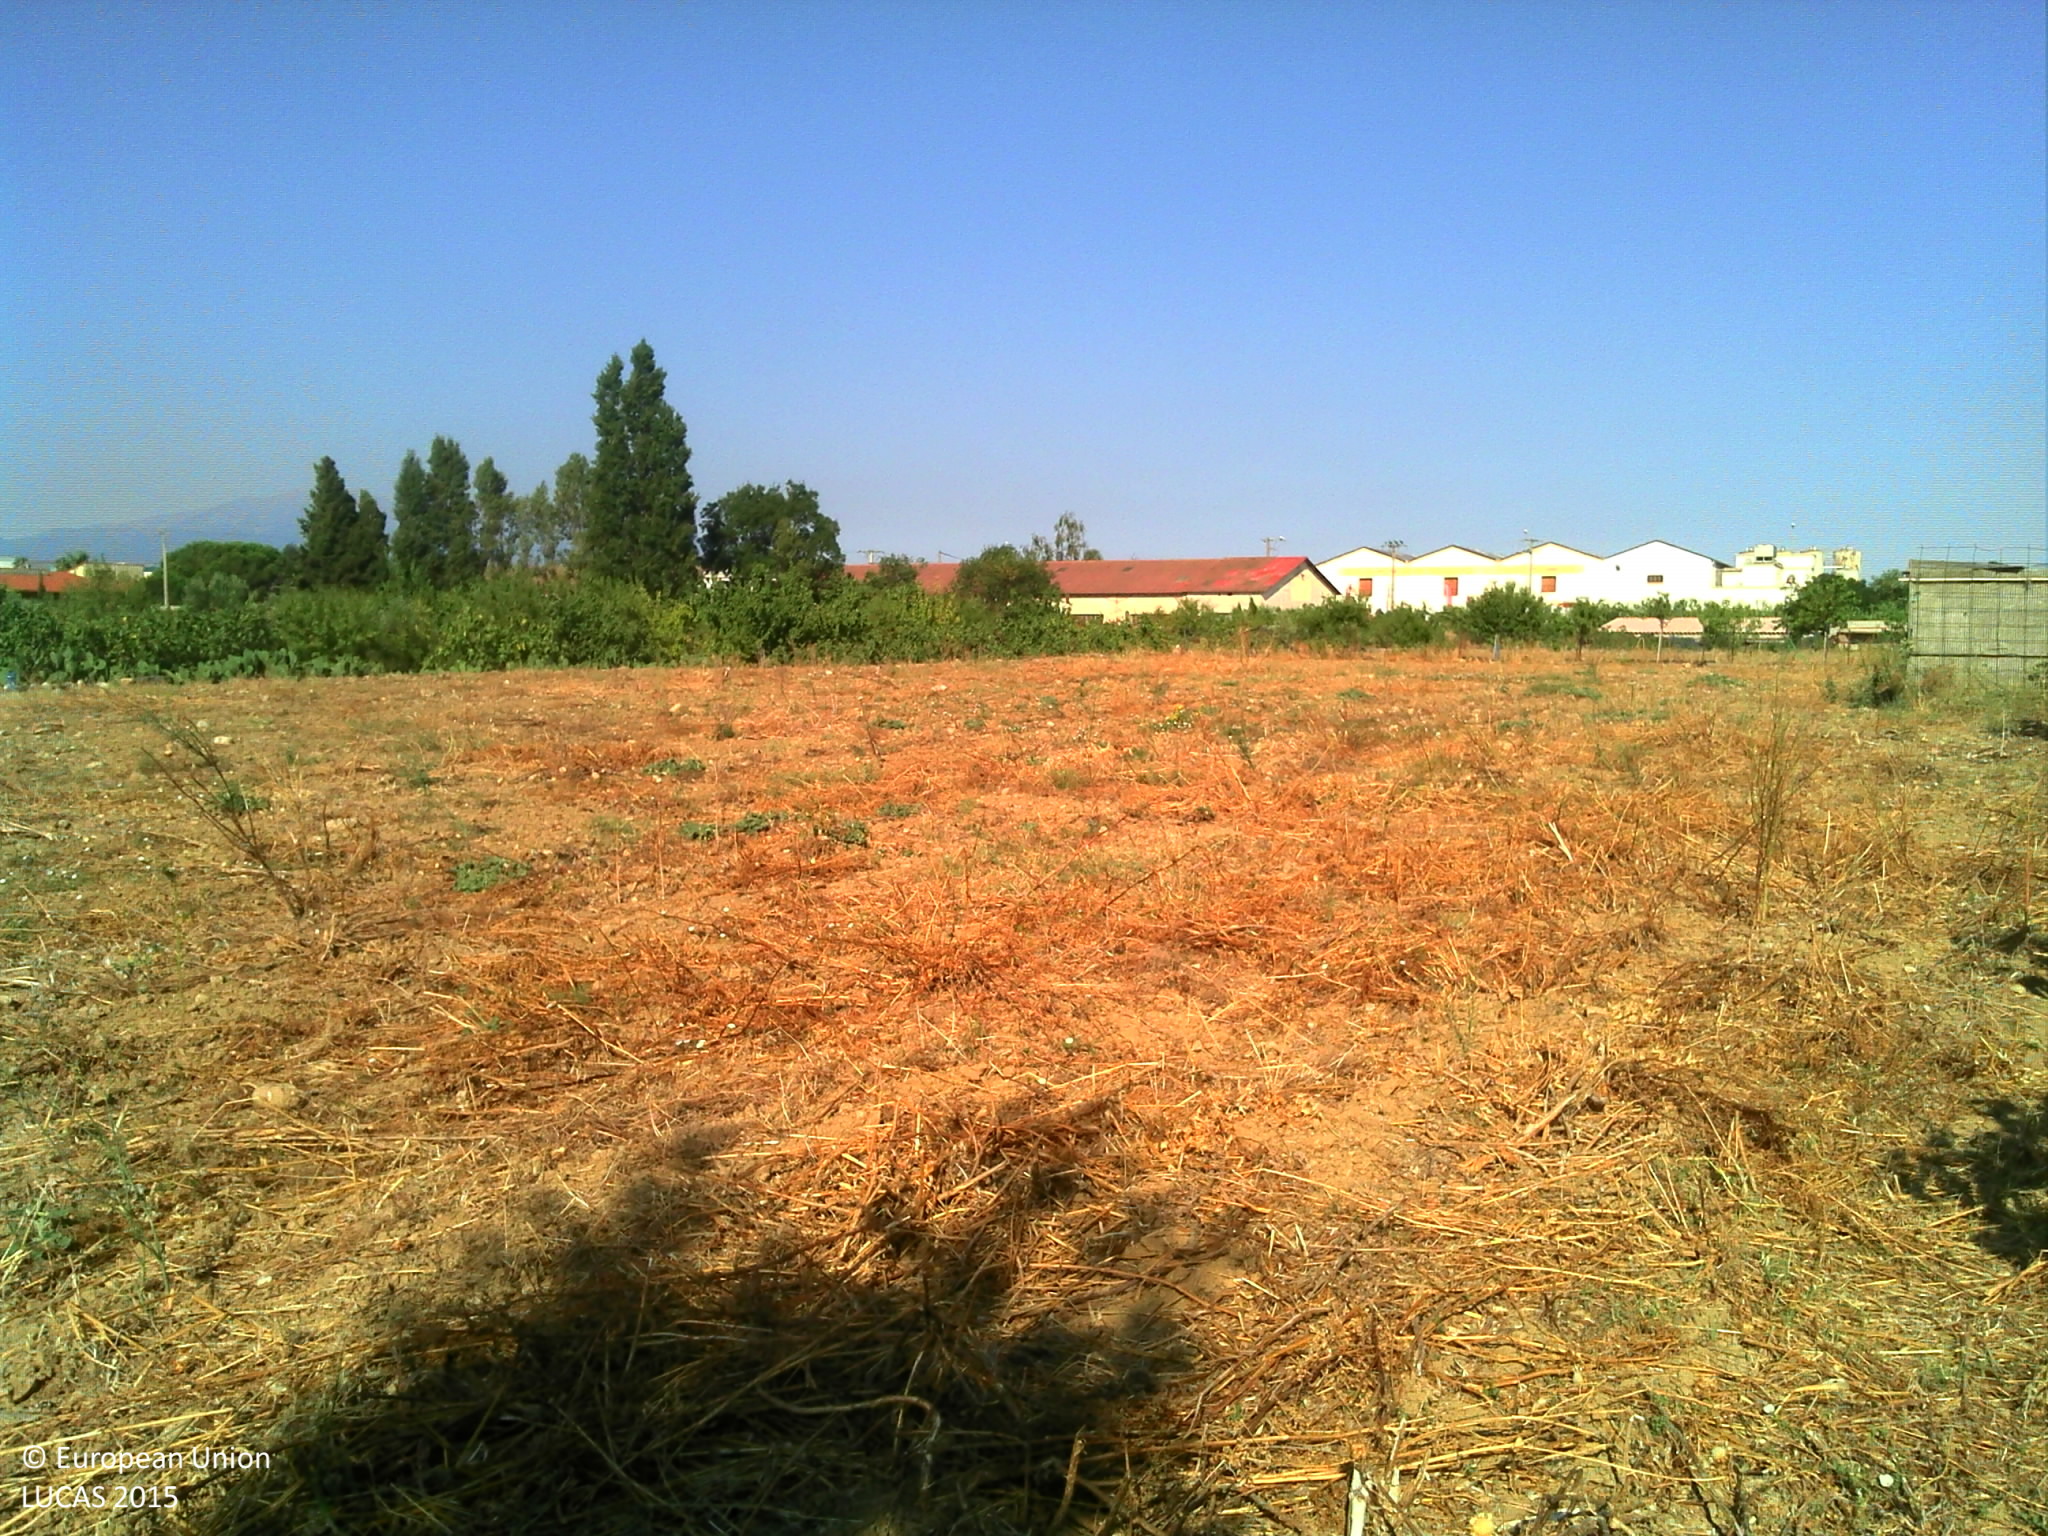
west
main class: Woodland
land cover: Broadleaved woodland
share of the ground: > 75 %
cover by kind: herbaceous plants 50 %, unconsolidated bare surface 25 %, broadleaved forest trees 20 %, shrubs 5 %
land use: Agriculture (excluding fallow land and kitchen gardens)
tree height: < 5 m
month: July
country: FR
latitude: 42.6387
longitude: 2.8778
